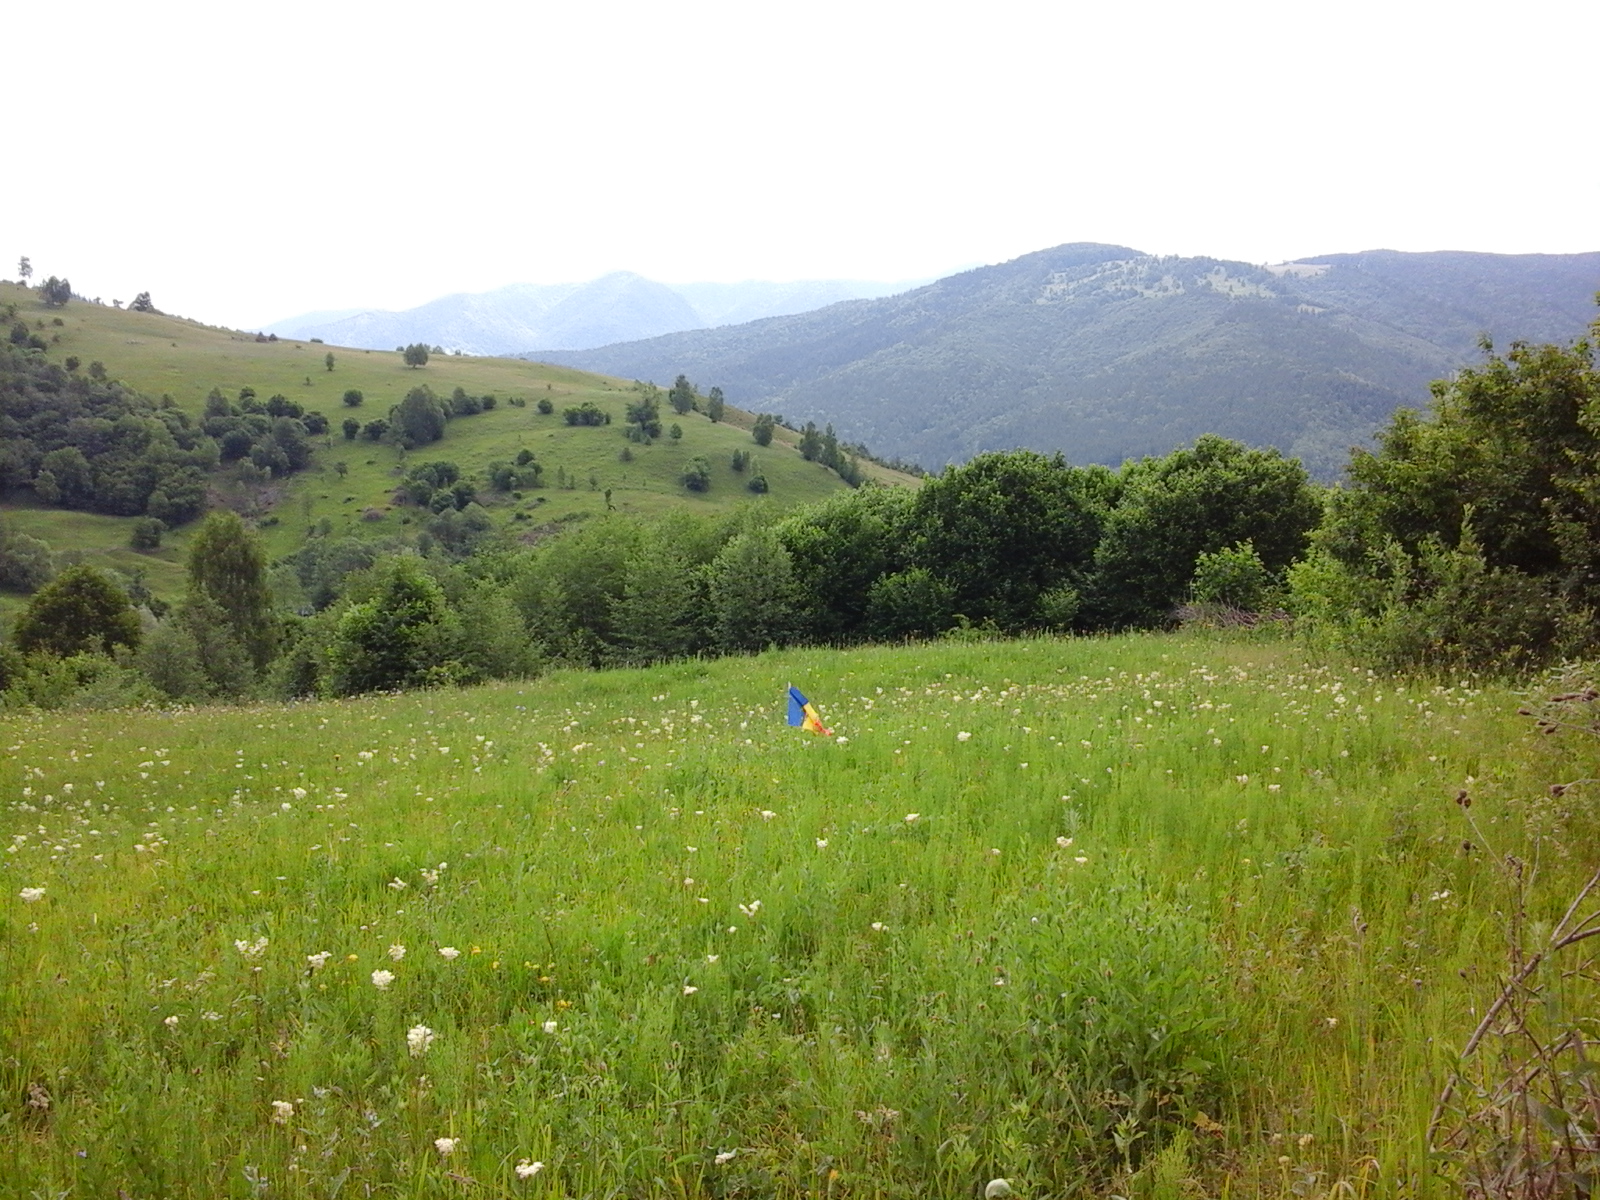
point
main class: Grassland
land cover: Grassland with sparse tree/shrub cover
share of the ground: > 75 %
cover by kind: herbaceous plants 85 %, shrubs 10 %, broadleaved forest trees 5 %
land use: Forestry
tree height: > 5 m
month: June
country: RO
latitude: 46.8854
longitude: 25.9627
